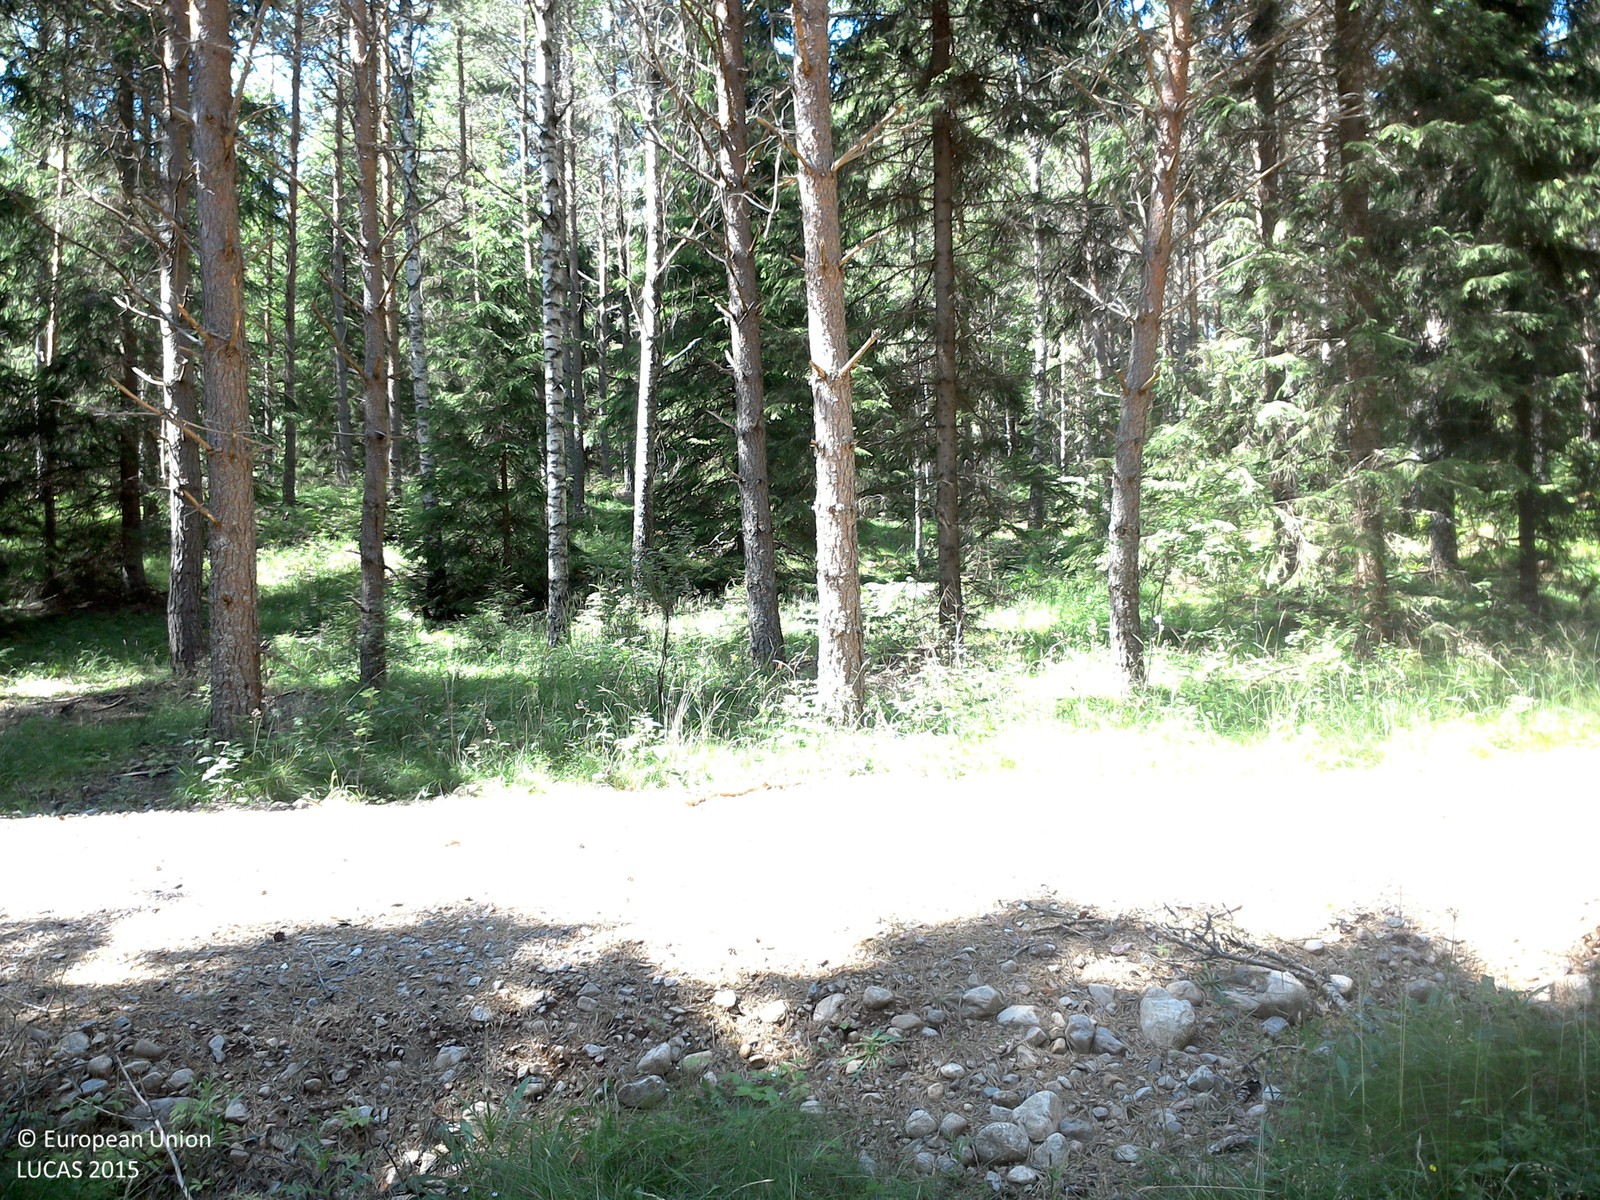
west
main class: Woodland
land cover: Pine dominated coniferous woodland
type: boreal forest
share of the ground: 50 - 75 %
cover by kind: coniferous forest trees 60 %, herbaceous plants 40 %
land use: Forestry
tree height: > 5 m
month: July
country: SE
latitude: 57.8920
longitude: 15.0051
